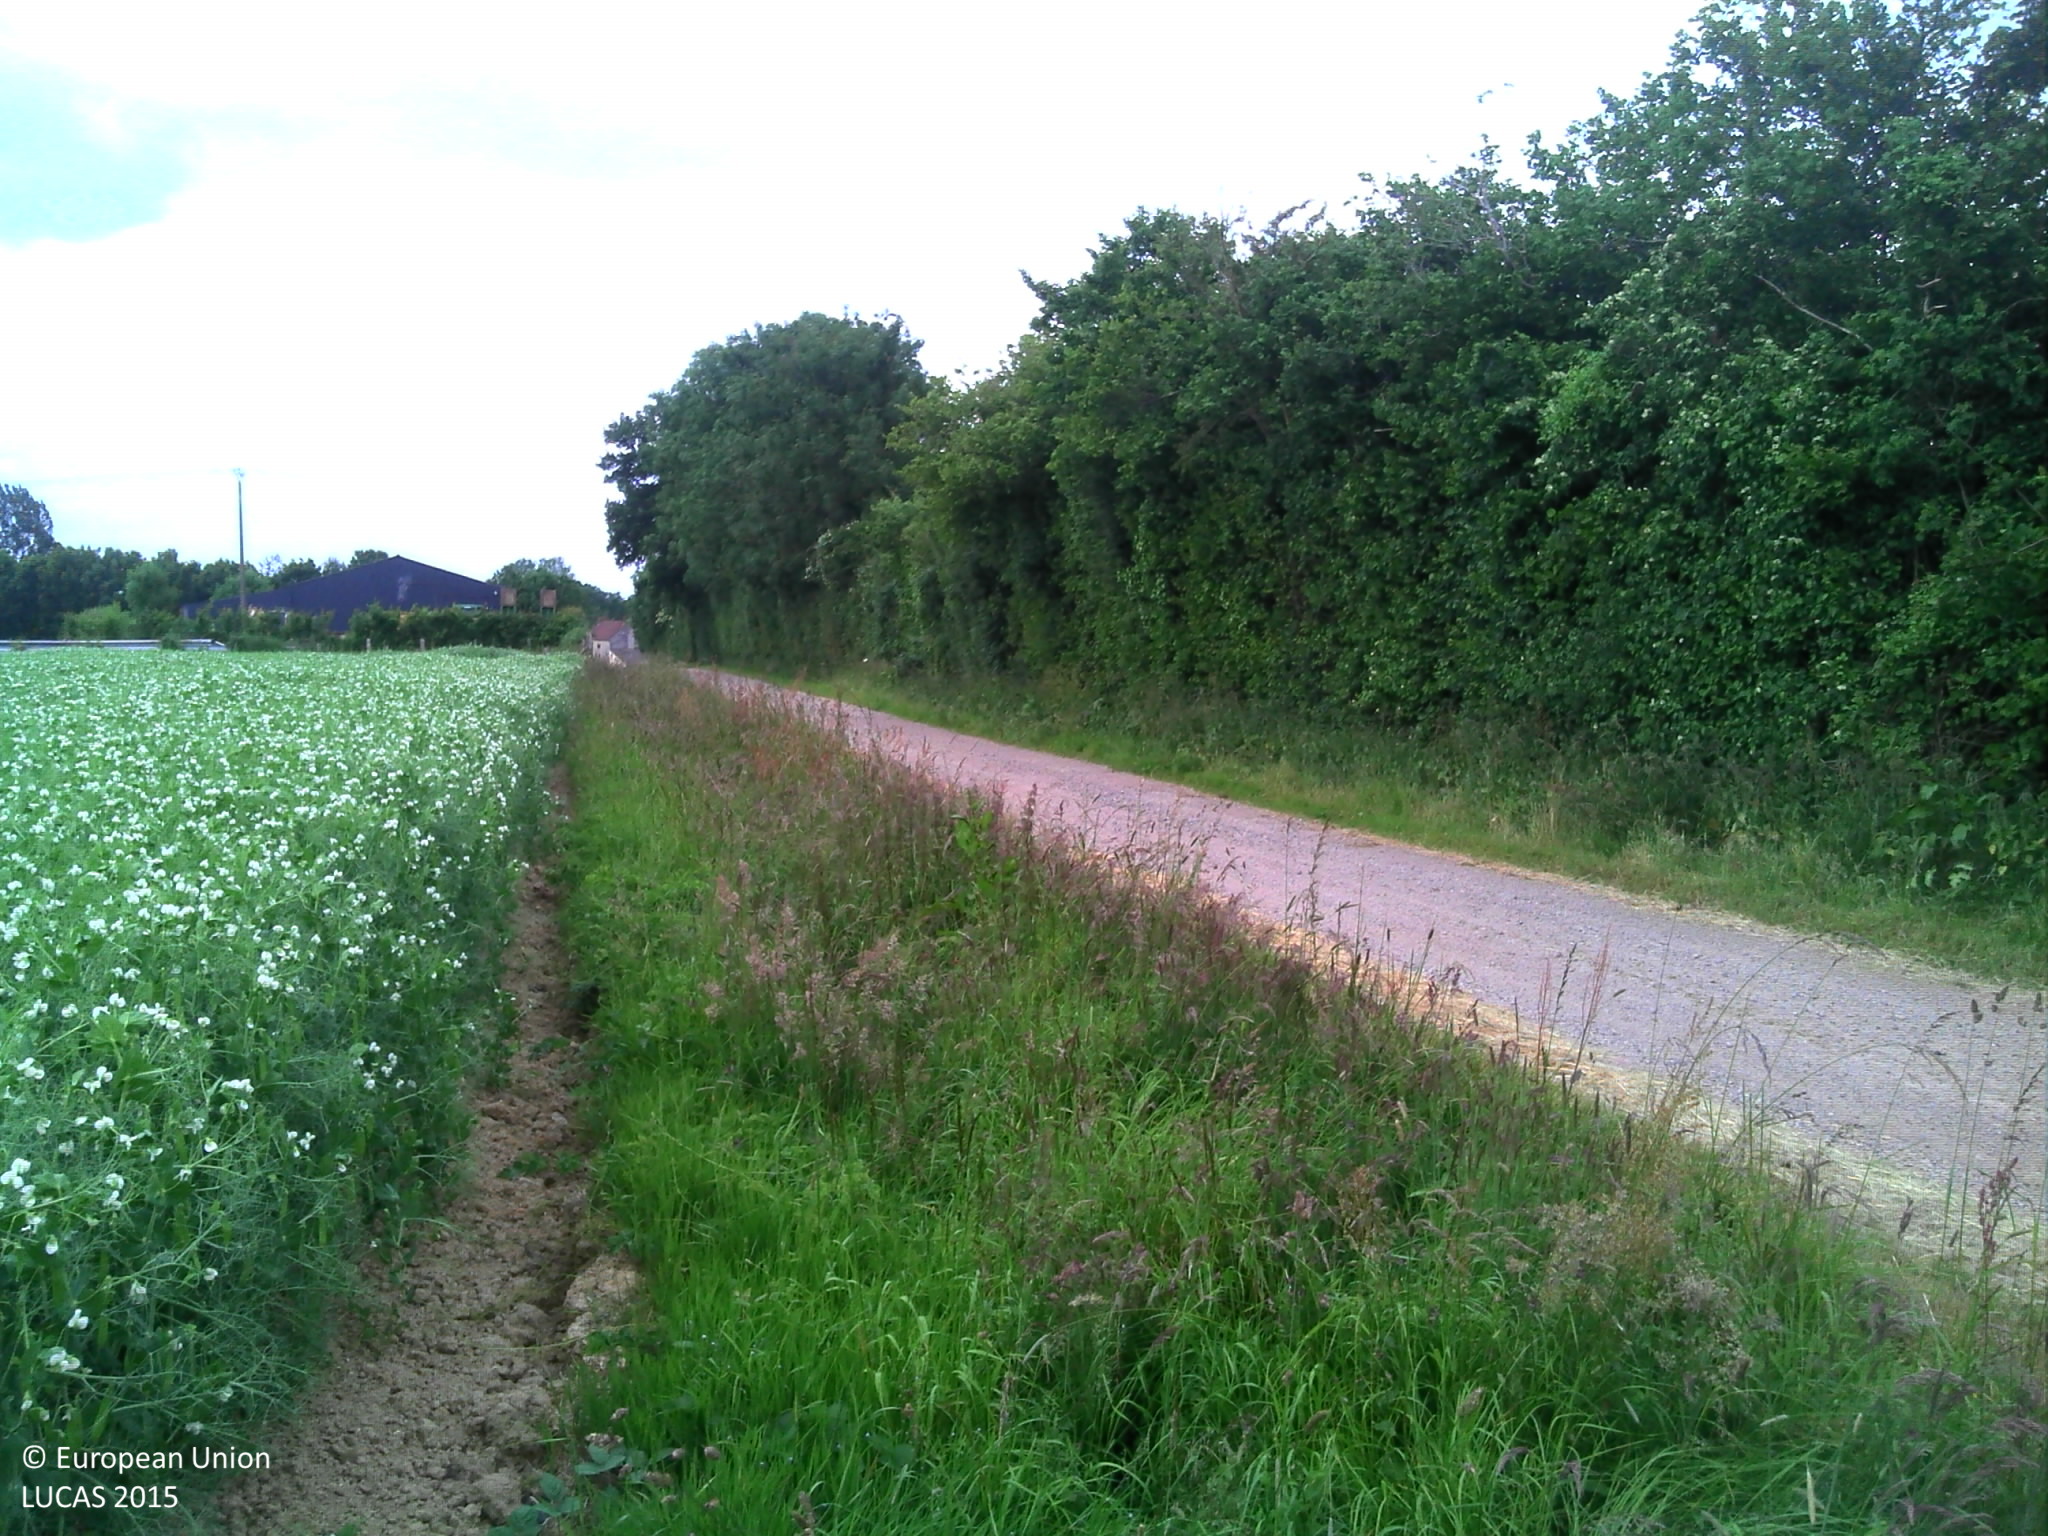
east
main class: Cropland
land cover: Dry pulses
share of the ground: > 75 %
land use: Agriculture (excluding fallow land and kitchen gardens)
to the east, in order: Dry pulses; Fences; Grassland without tree/shrub cover; Artificial constructions in urban areas; Grassland without tree/shrub cover; Fences; Ditches and canals; Grass margins; Paved roads, cycling and walking lanes; Grass margins; Ditches and canals; Fences; Grassland with sparse tree/shrub cover
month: June
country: FR
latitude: 48.5654
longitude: 0.2019
